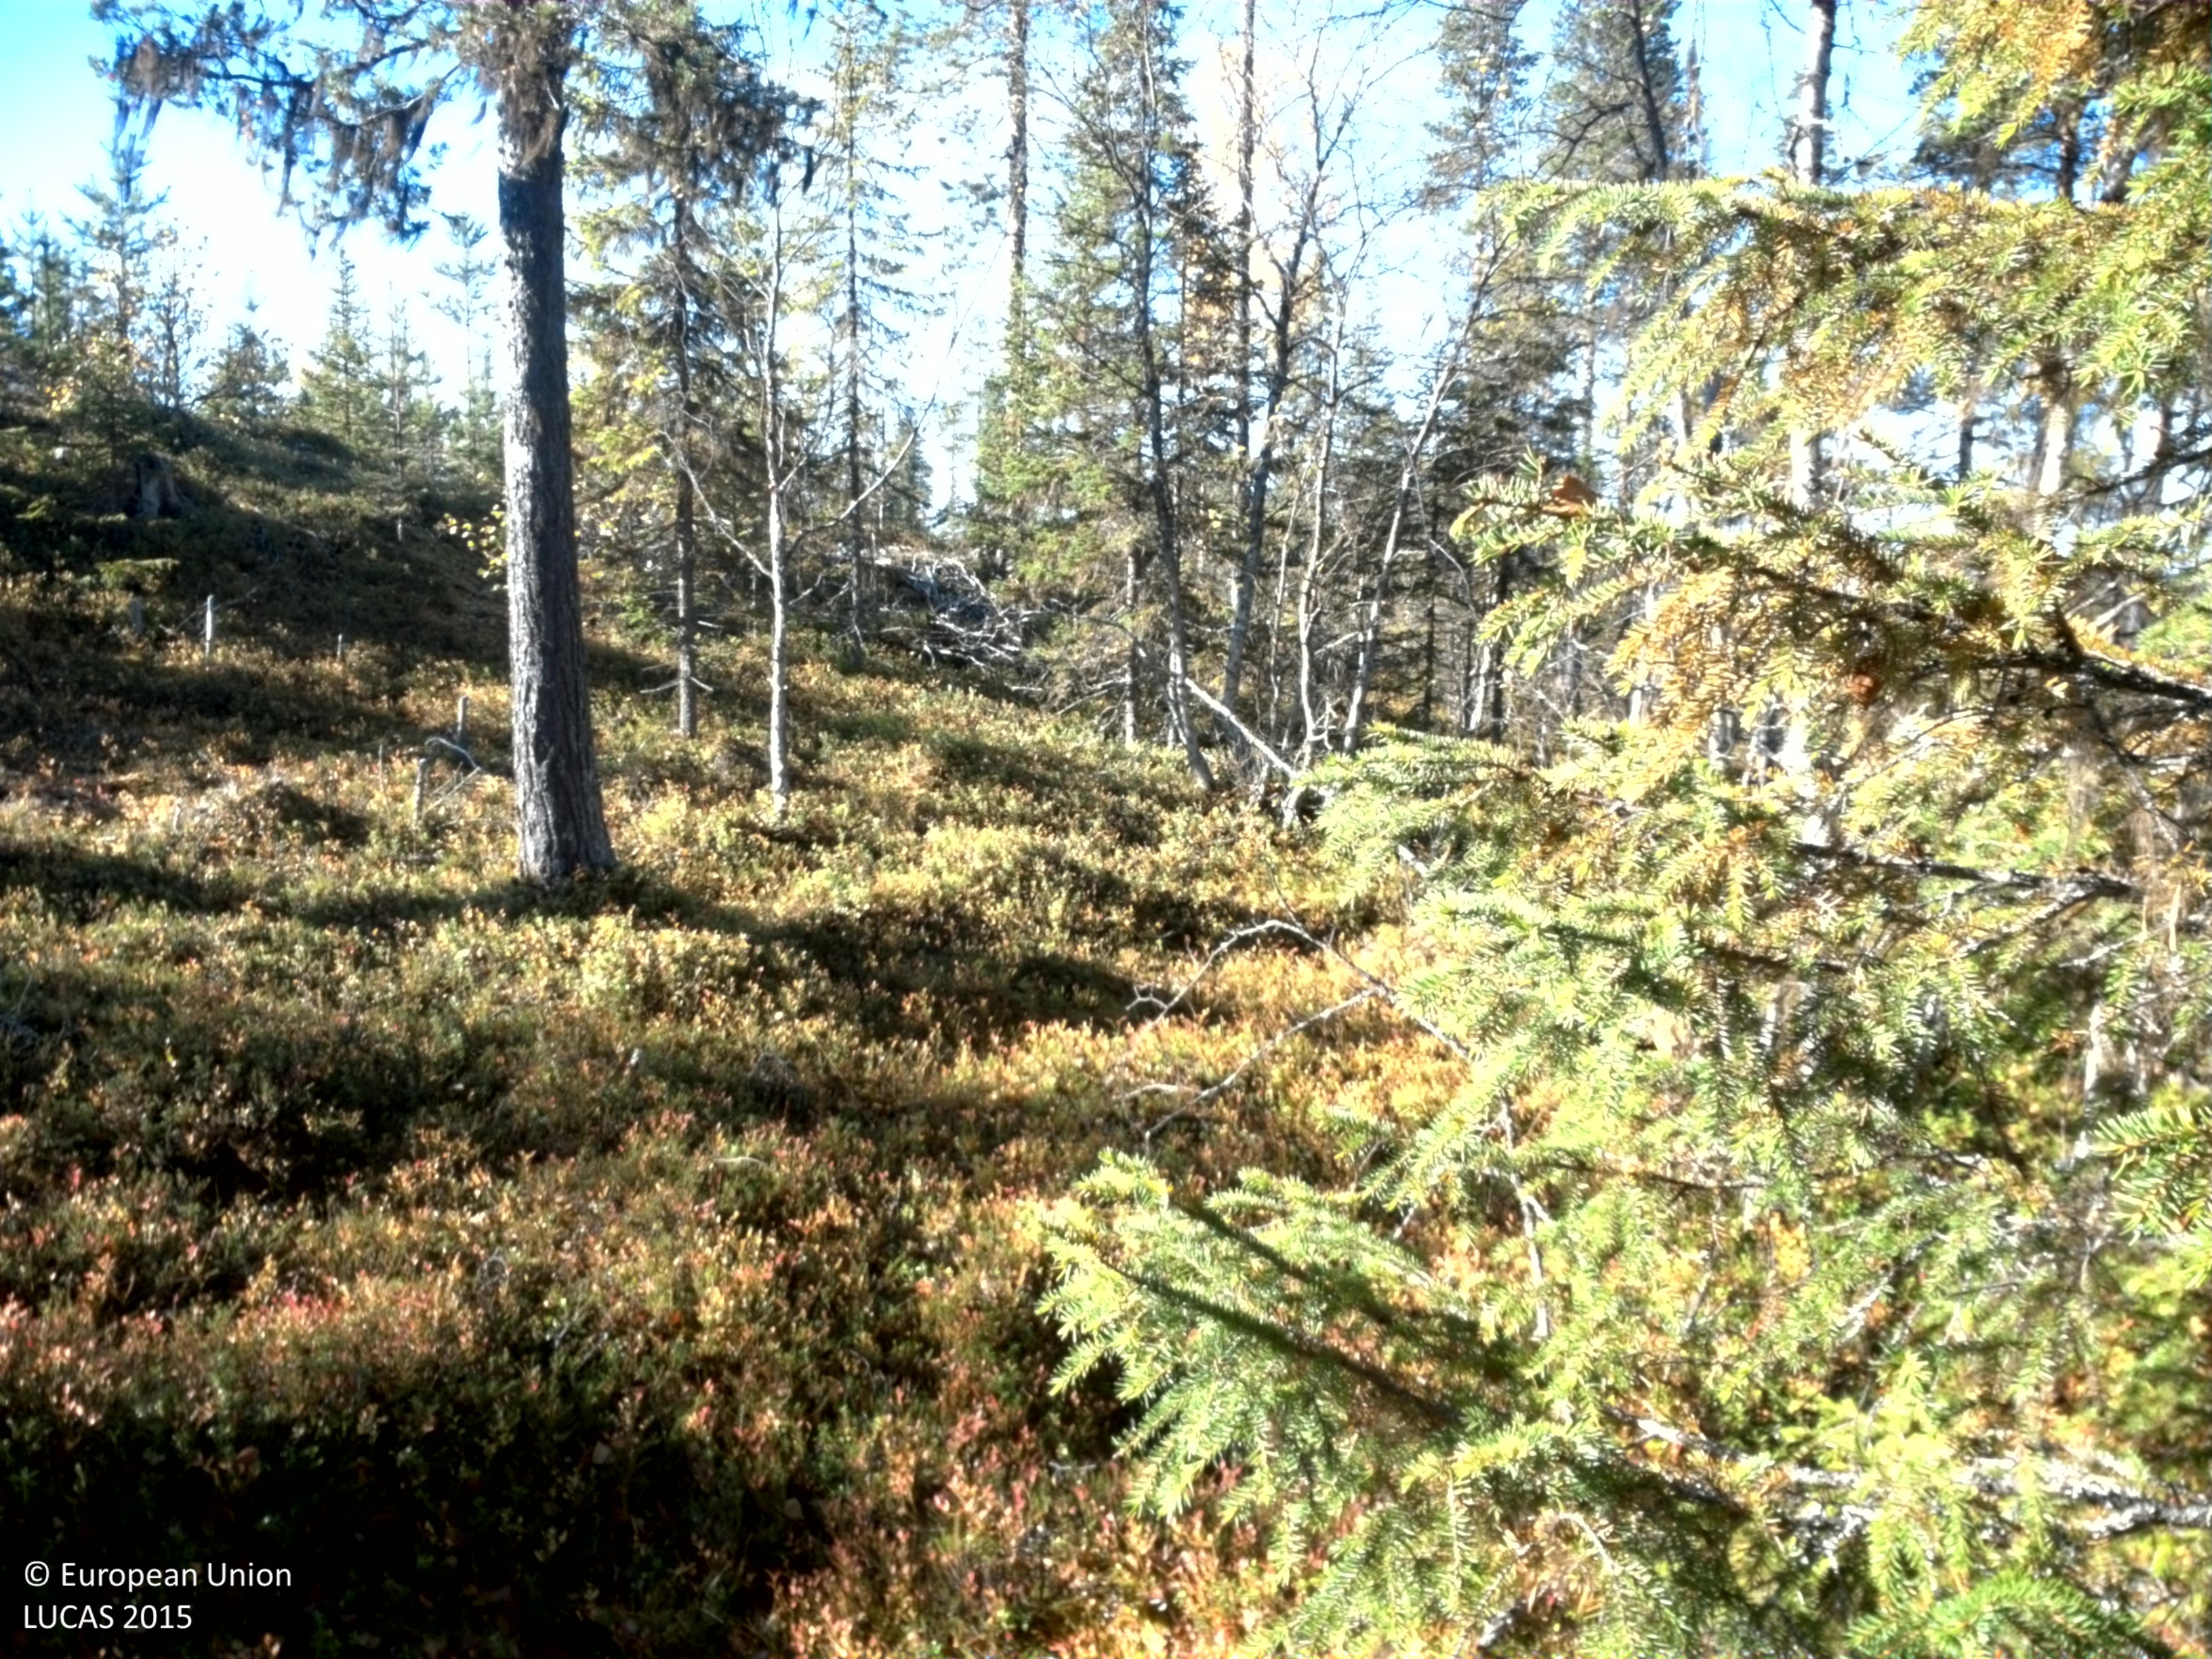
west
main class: Woodland
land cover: Spruce dominated mixed woodland
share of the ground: 25 - 50 %
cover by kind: shrubs 50 %, coniferous forest trees 20 %, broadleaved forest trees 15 %, lichens and mosses 10 %, herbaceous plants 5 %
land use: Forestry
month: September
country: SE
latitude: 64.9681
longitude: 17.8221
